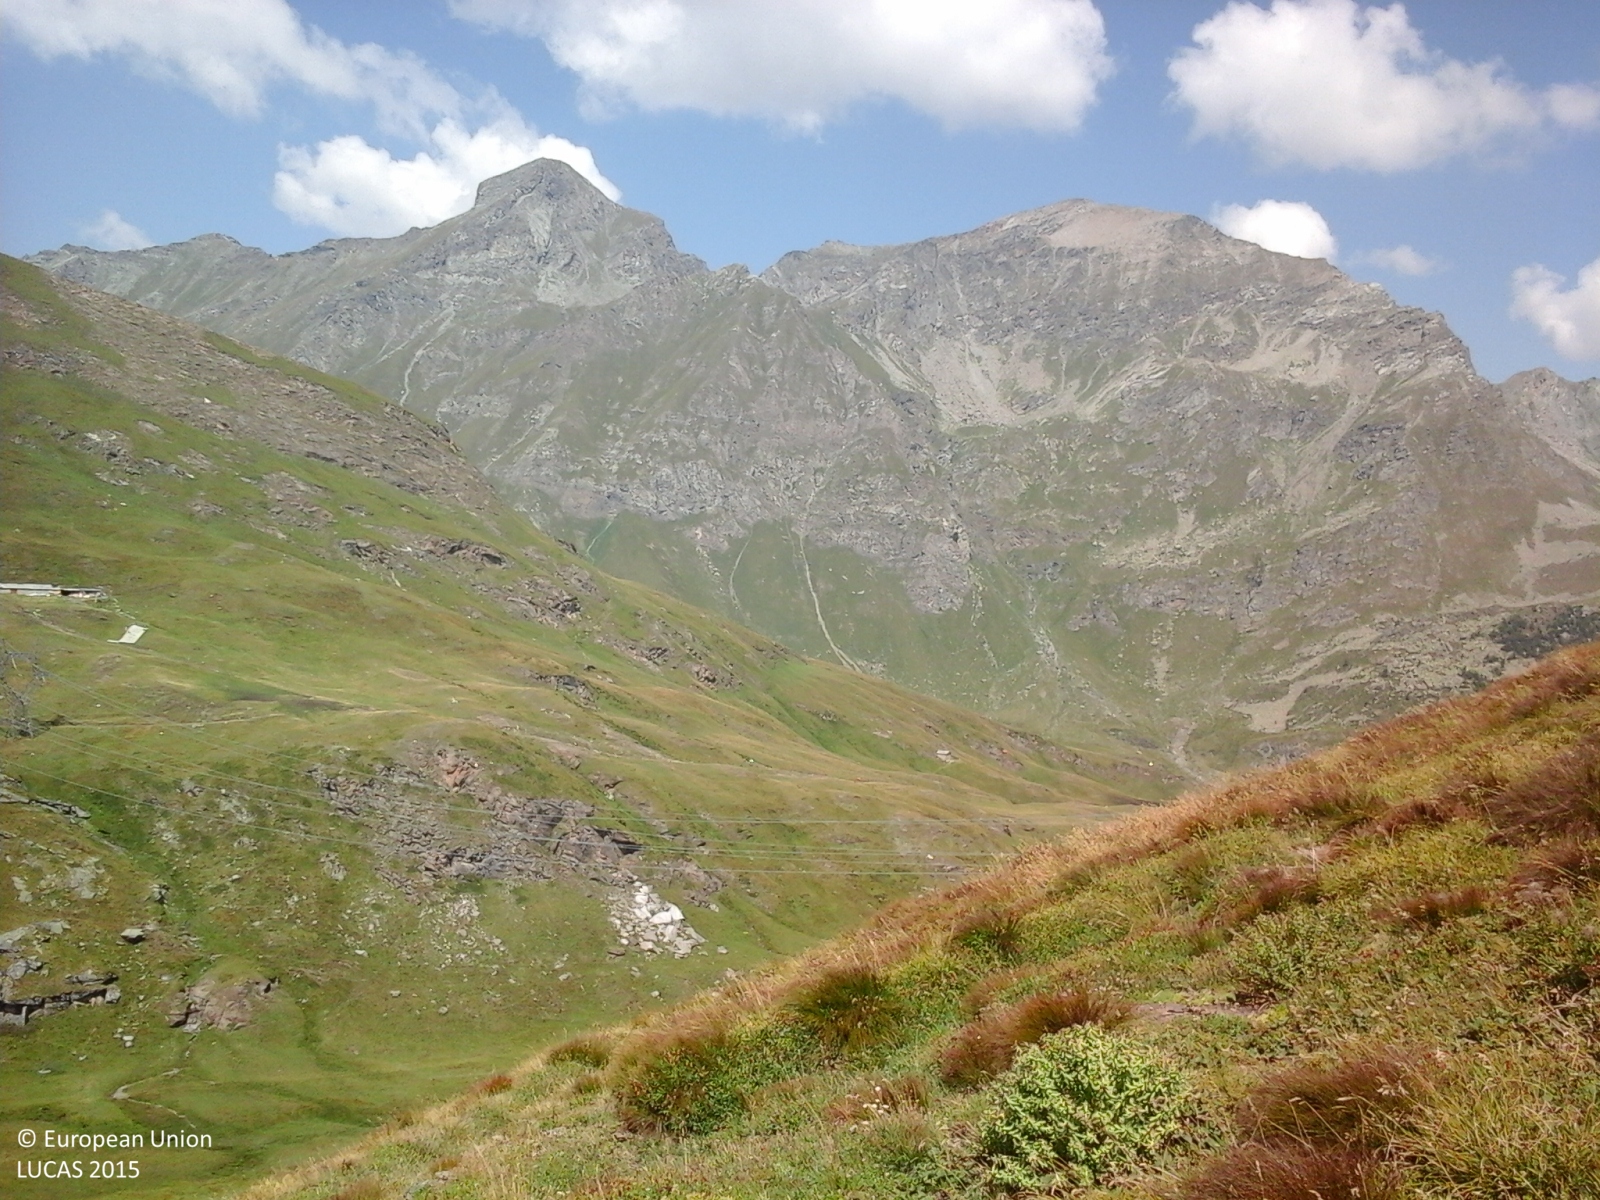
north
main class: Grassland
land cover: Grassland without tree/shrub cover
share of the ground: > 75 %
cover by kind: herbaceous plants 100 %
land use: Agriculture (excluding fallow land and kitchen gardens)
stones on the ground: < 10 %
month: August
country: IT
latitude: 45.6023
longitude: 7.5548
